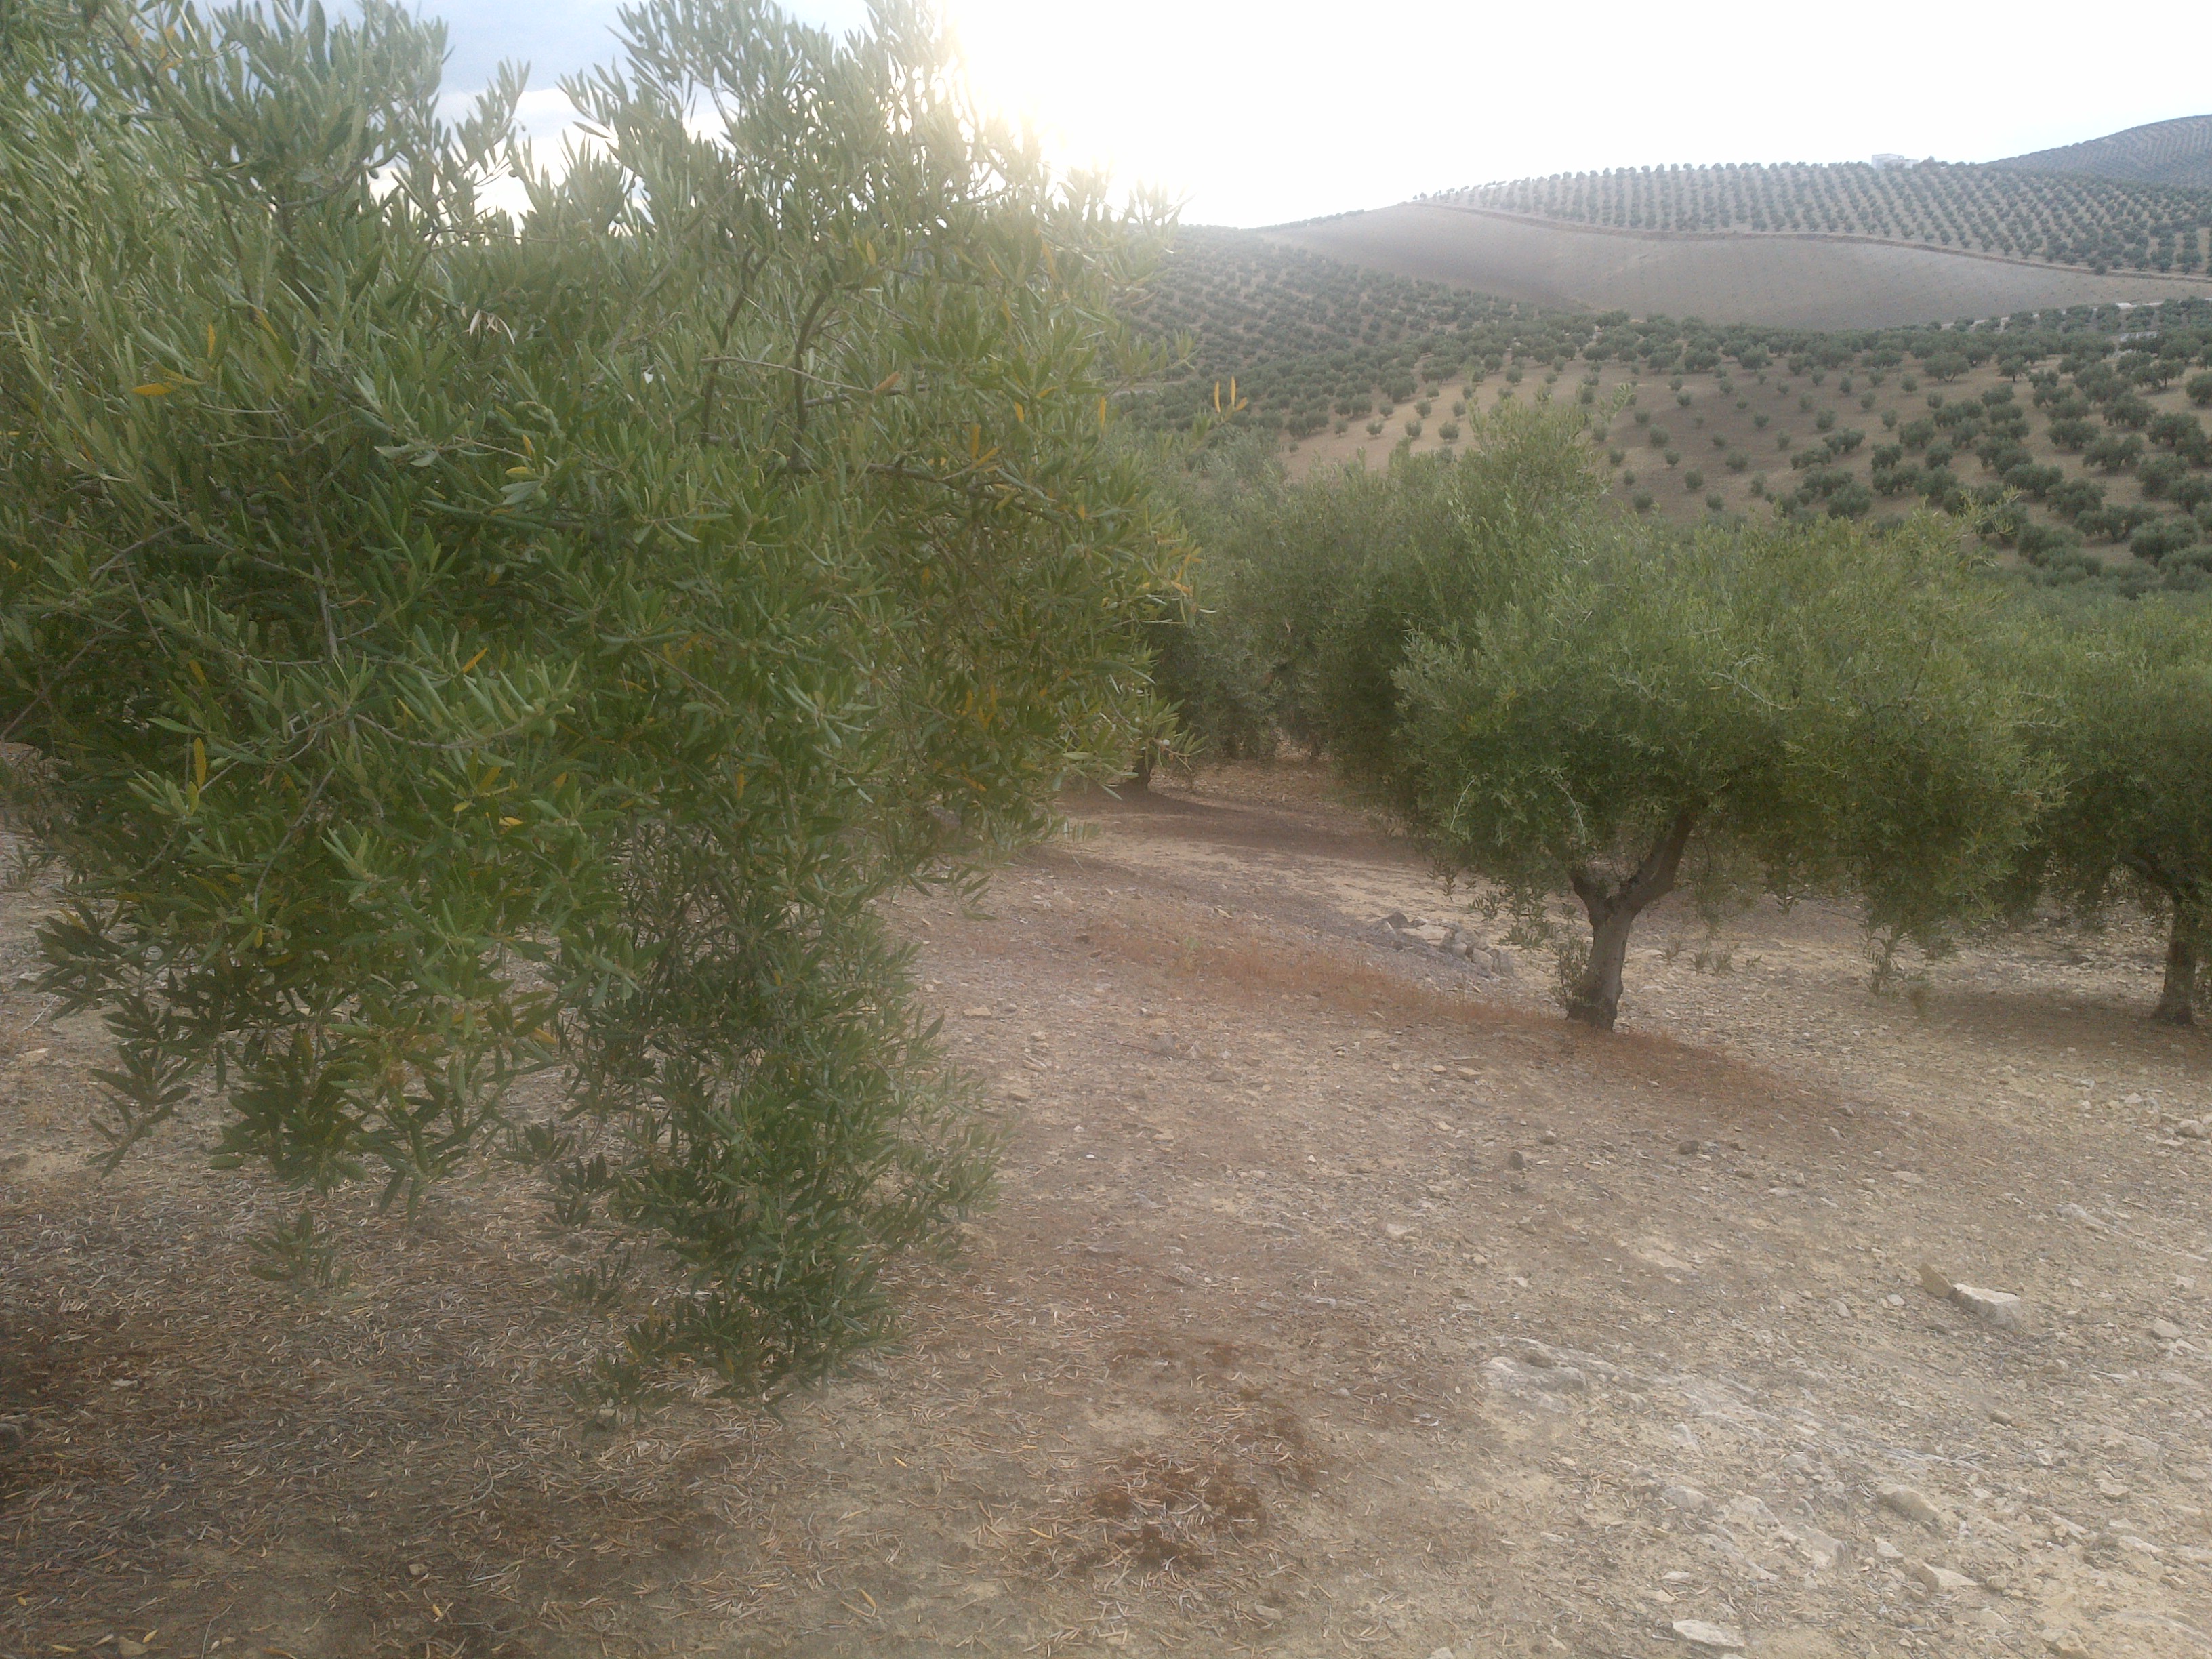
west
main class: Cropland
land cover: Olive groves
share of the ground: 25 - 50 %
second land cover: Other bare soil
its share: > 75 %
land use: Agriculture (excluding fallow land and kitchen gardens)
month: June
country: ES
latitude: 37.7011
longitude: -4.4684
